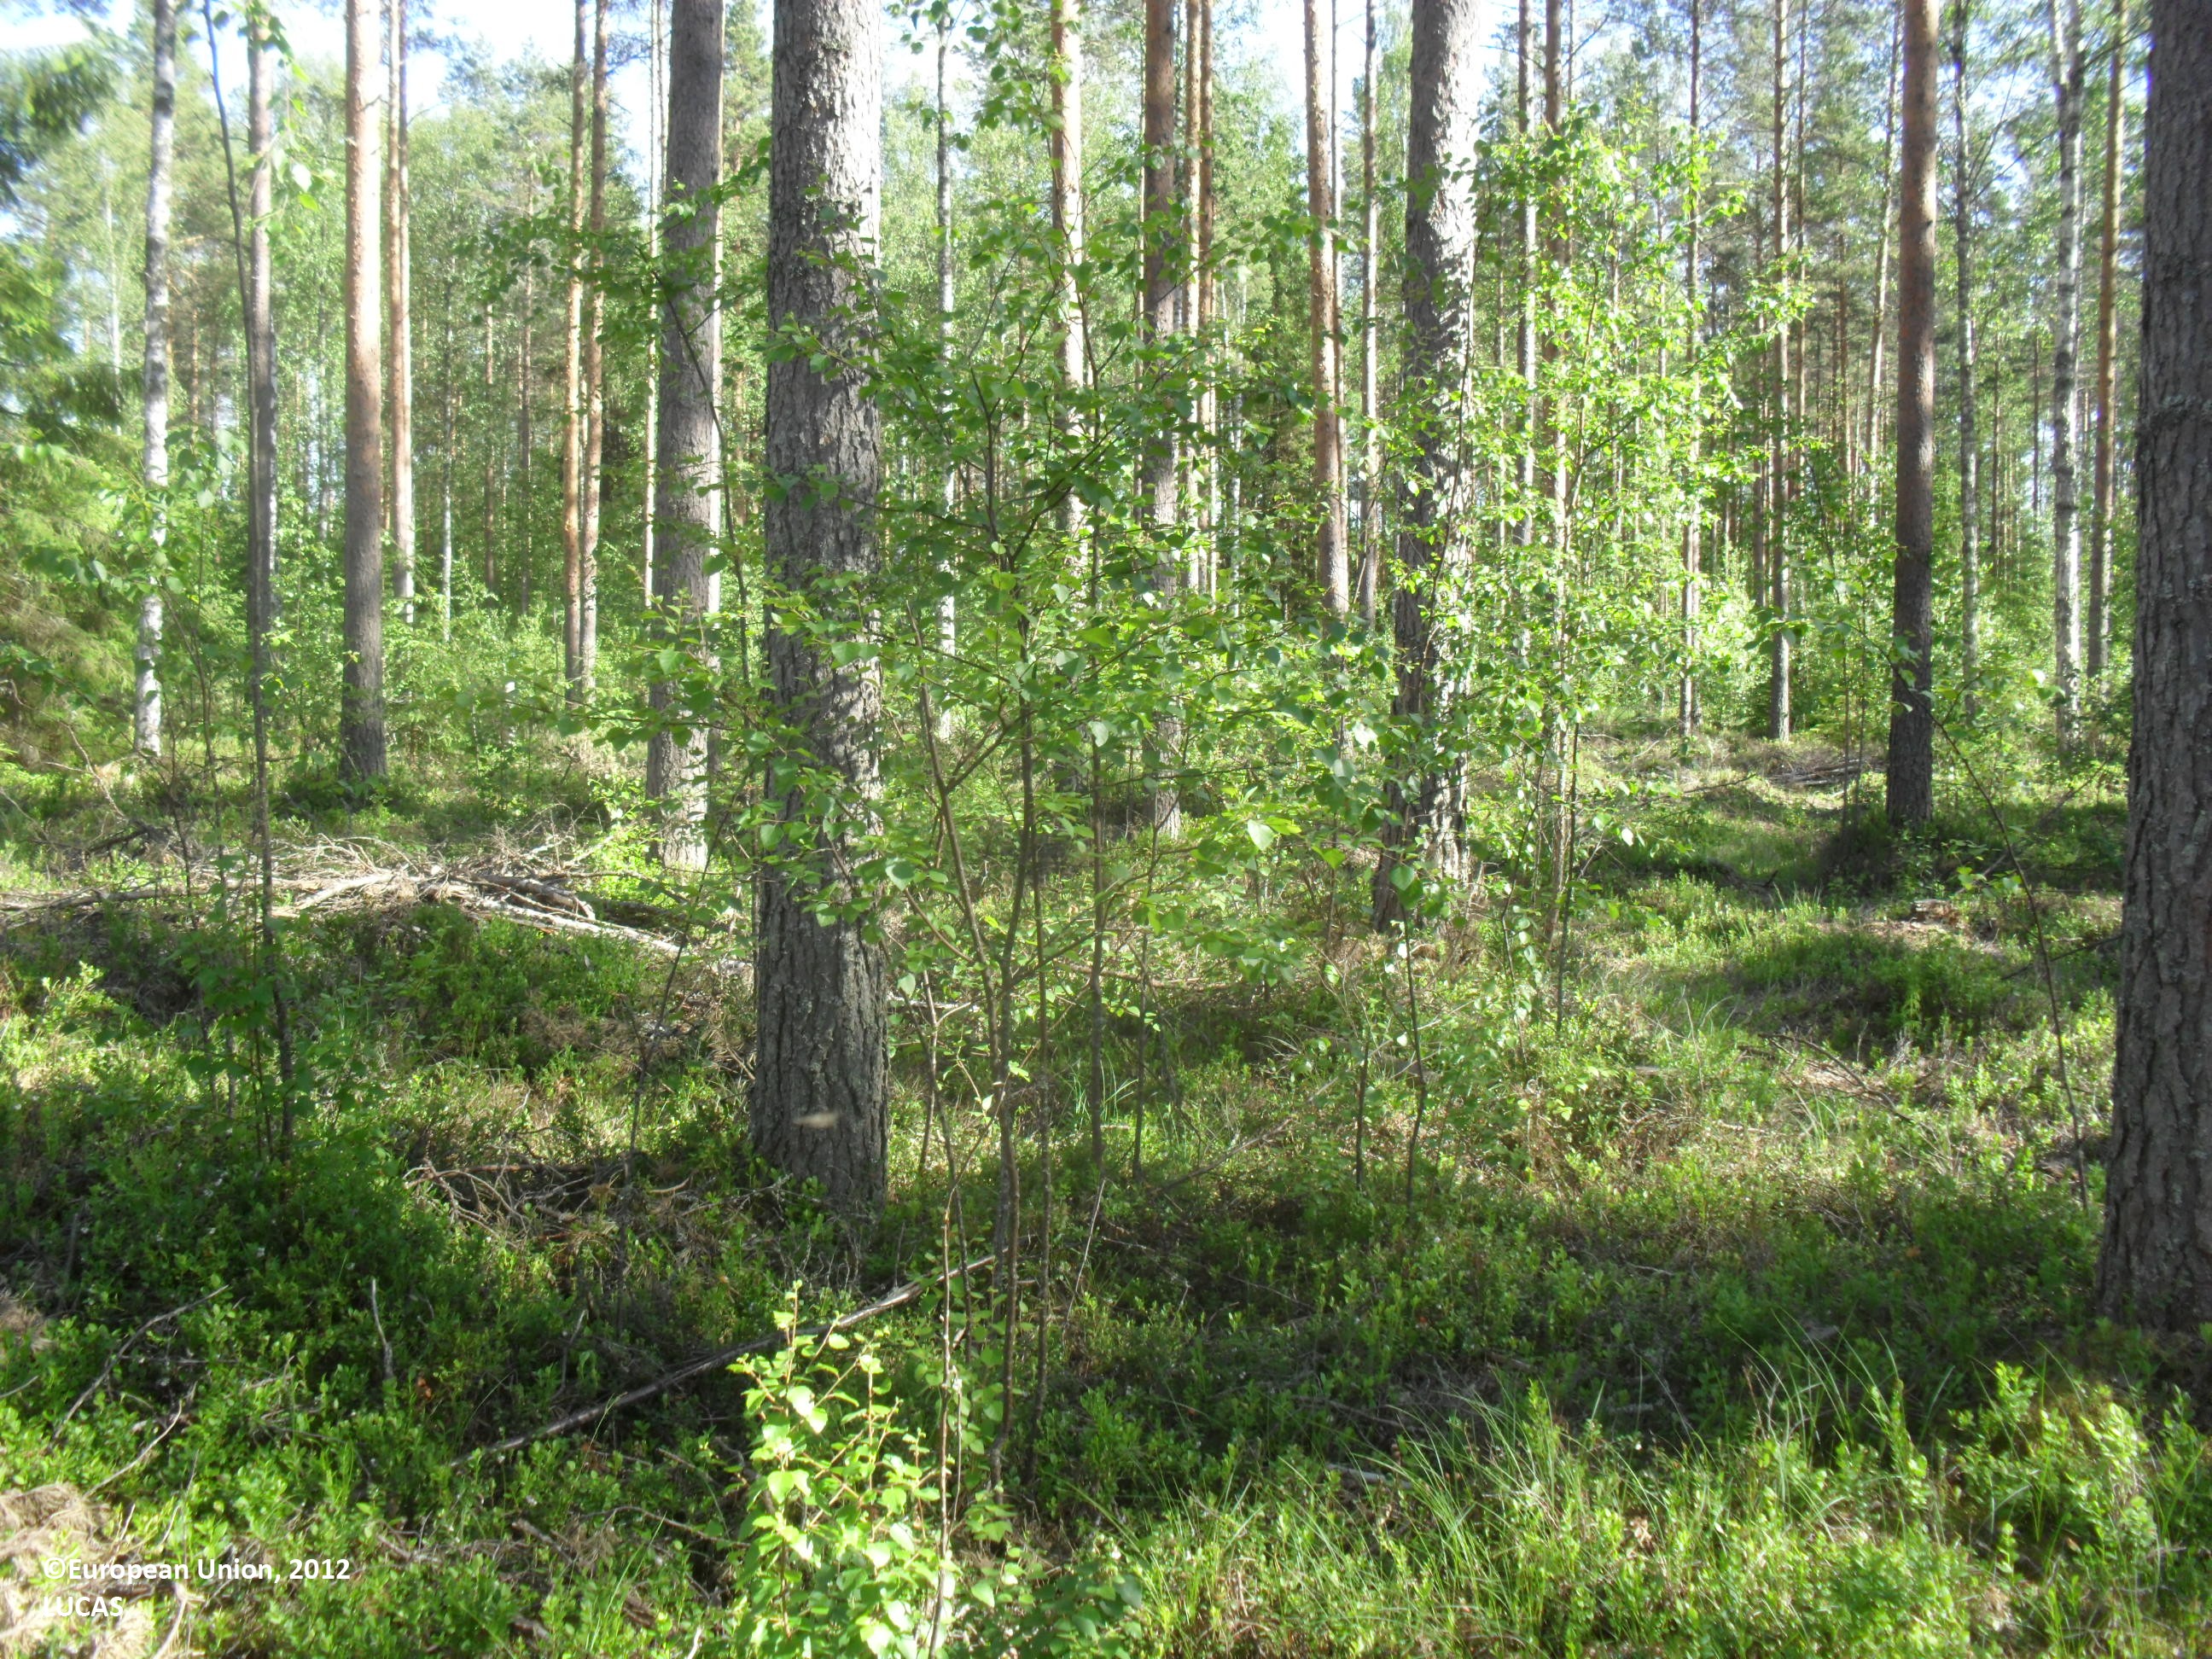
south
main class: Woodland
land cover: Pine dominated mixed woodland
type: boreal forest
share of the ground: 50 - 75 %
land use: Forestry
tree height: > 5 m
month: June
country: FI
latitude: 62.9665
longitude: 23.7778
